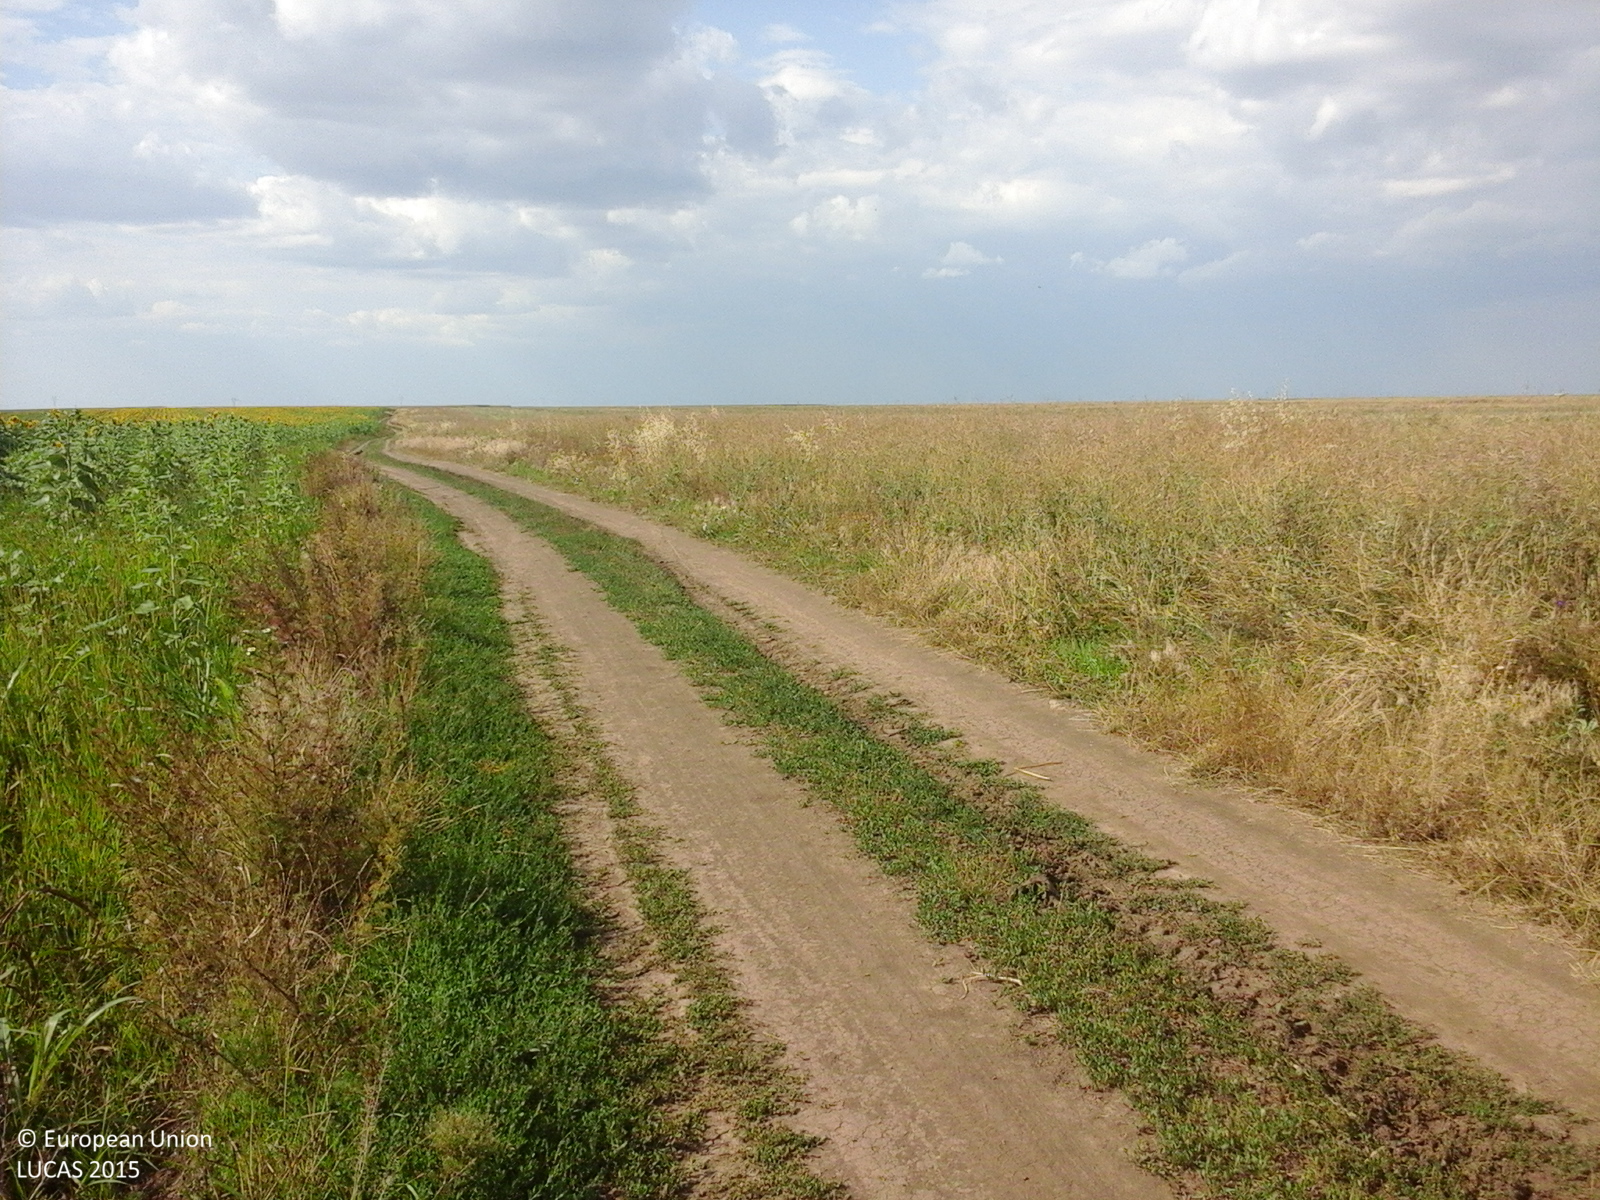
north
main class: Cropland
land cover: Maize
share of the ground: > 75 %
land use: Agriculture (excluding fallow land and kitchen gardens)
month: July
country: RO
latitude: 43.8297
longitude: 25.1874
